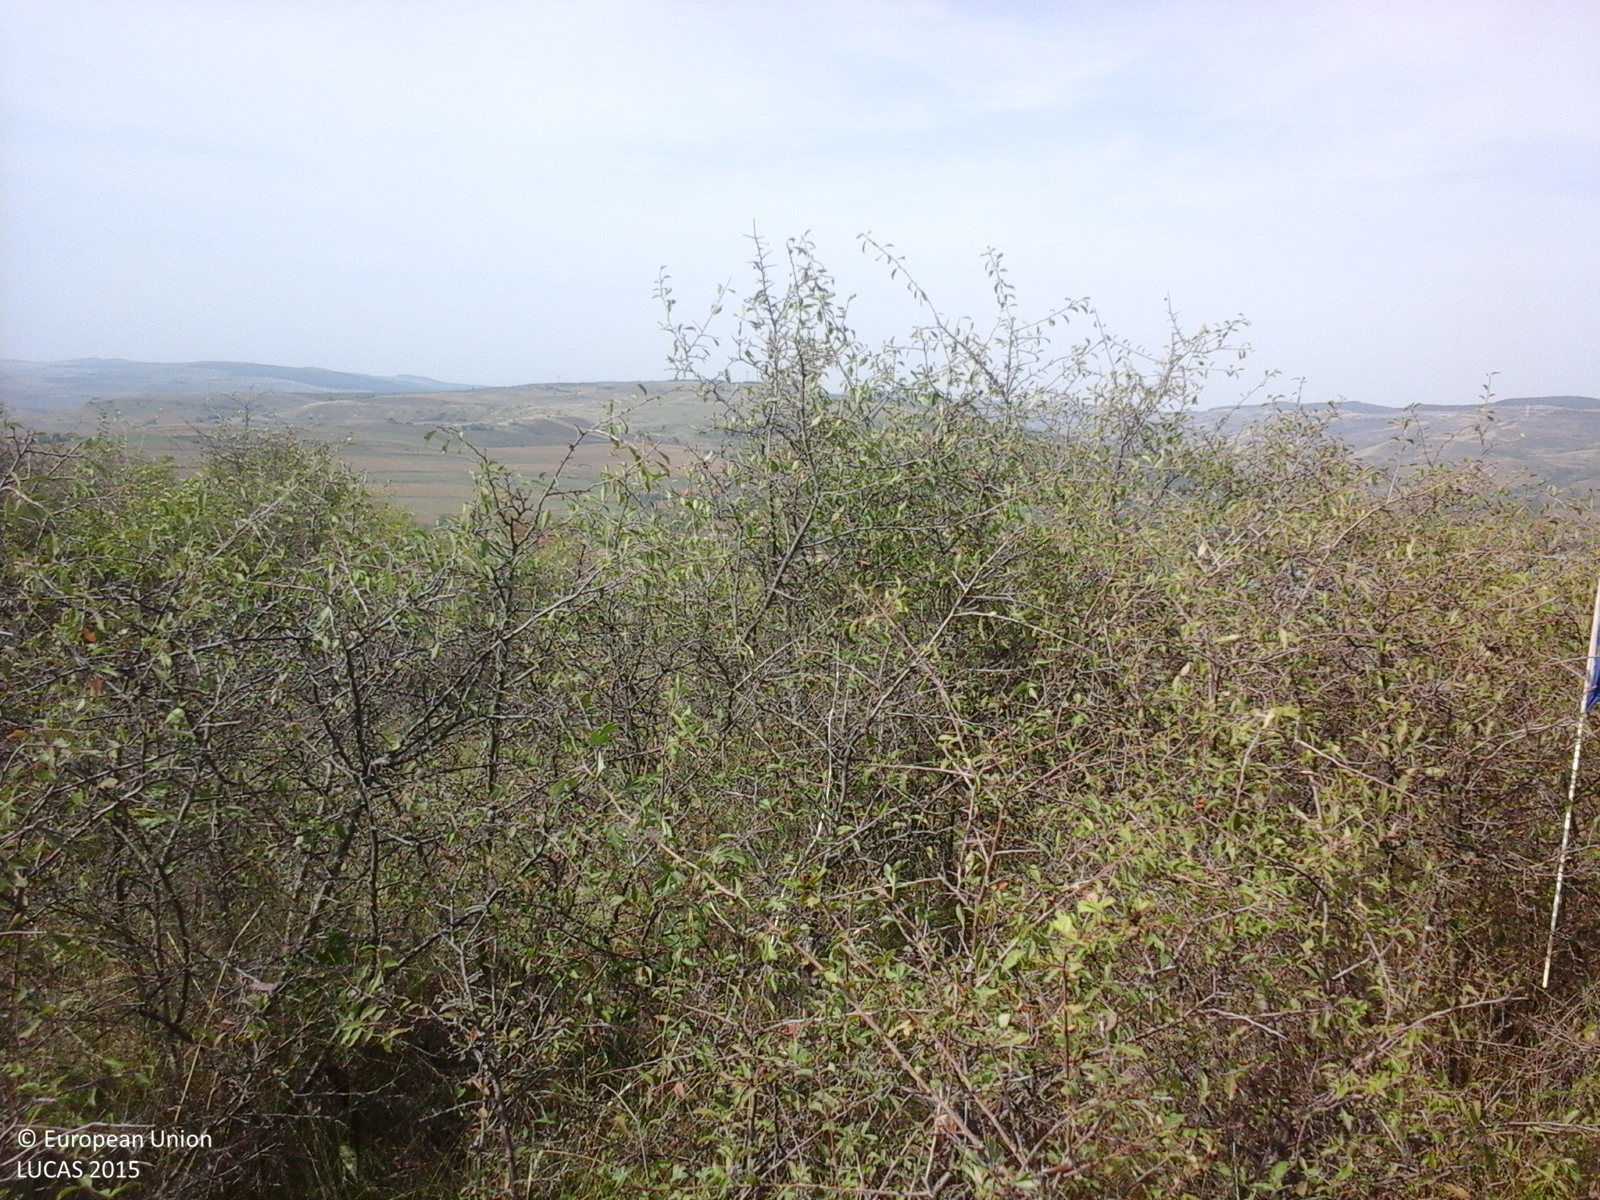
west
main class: Shrubland
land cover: Shrubland with sparse tree cover
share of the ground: > 75 %
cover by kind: herbaceous plants 55 %, shrubs 40 %, broadleaved forest trees 5 %
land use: Fallow land
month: September
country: RO
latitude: 46.8933
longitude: 24.0856
